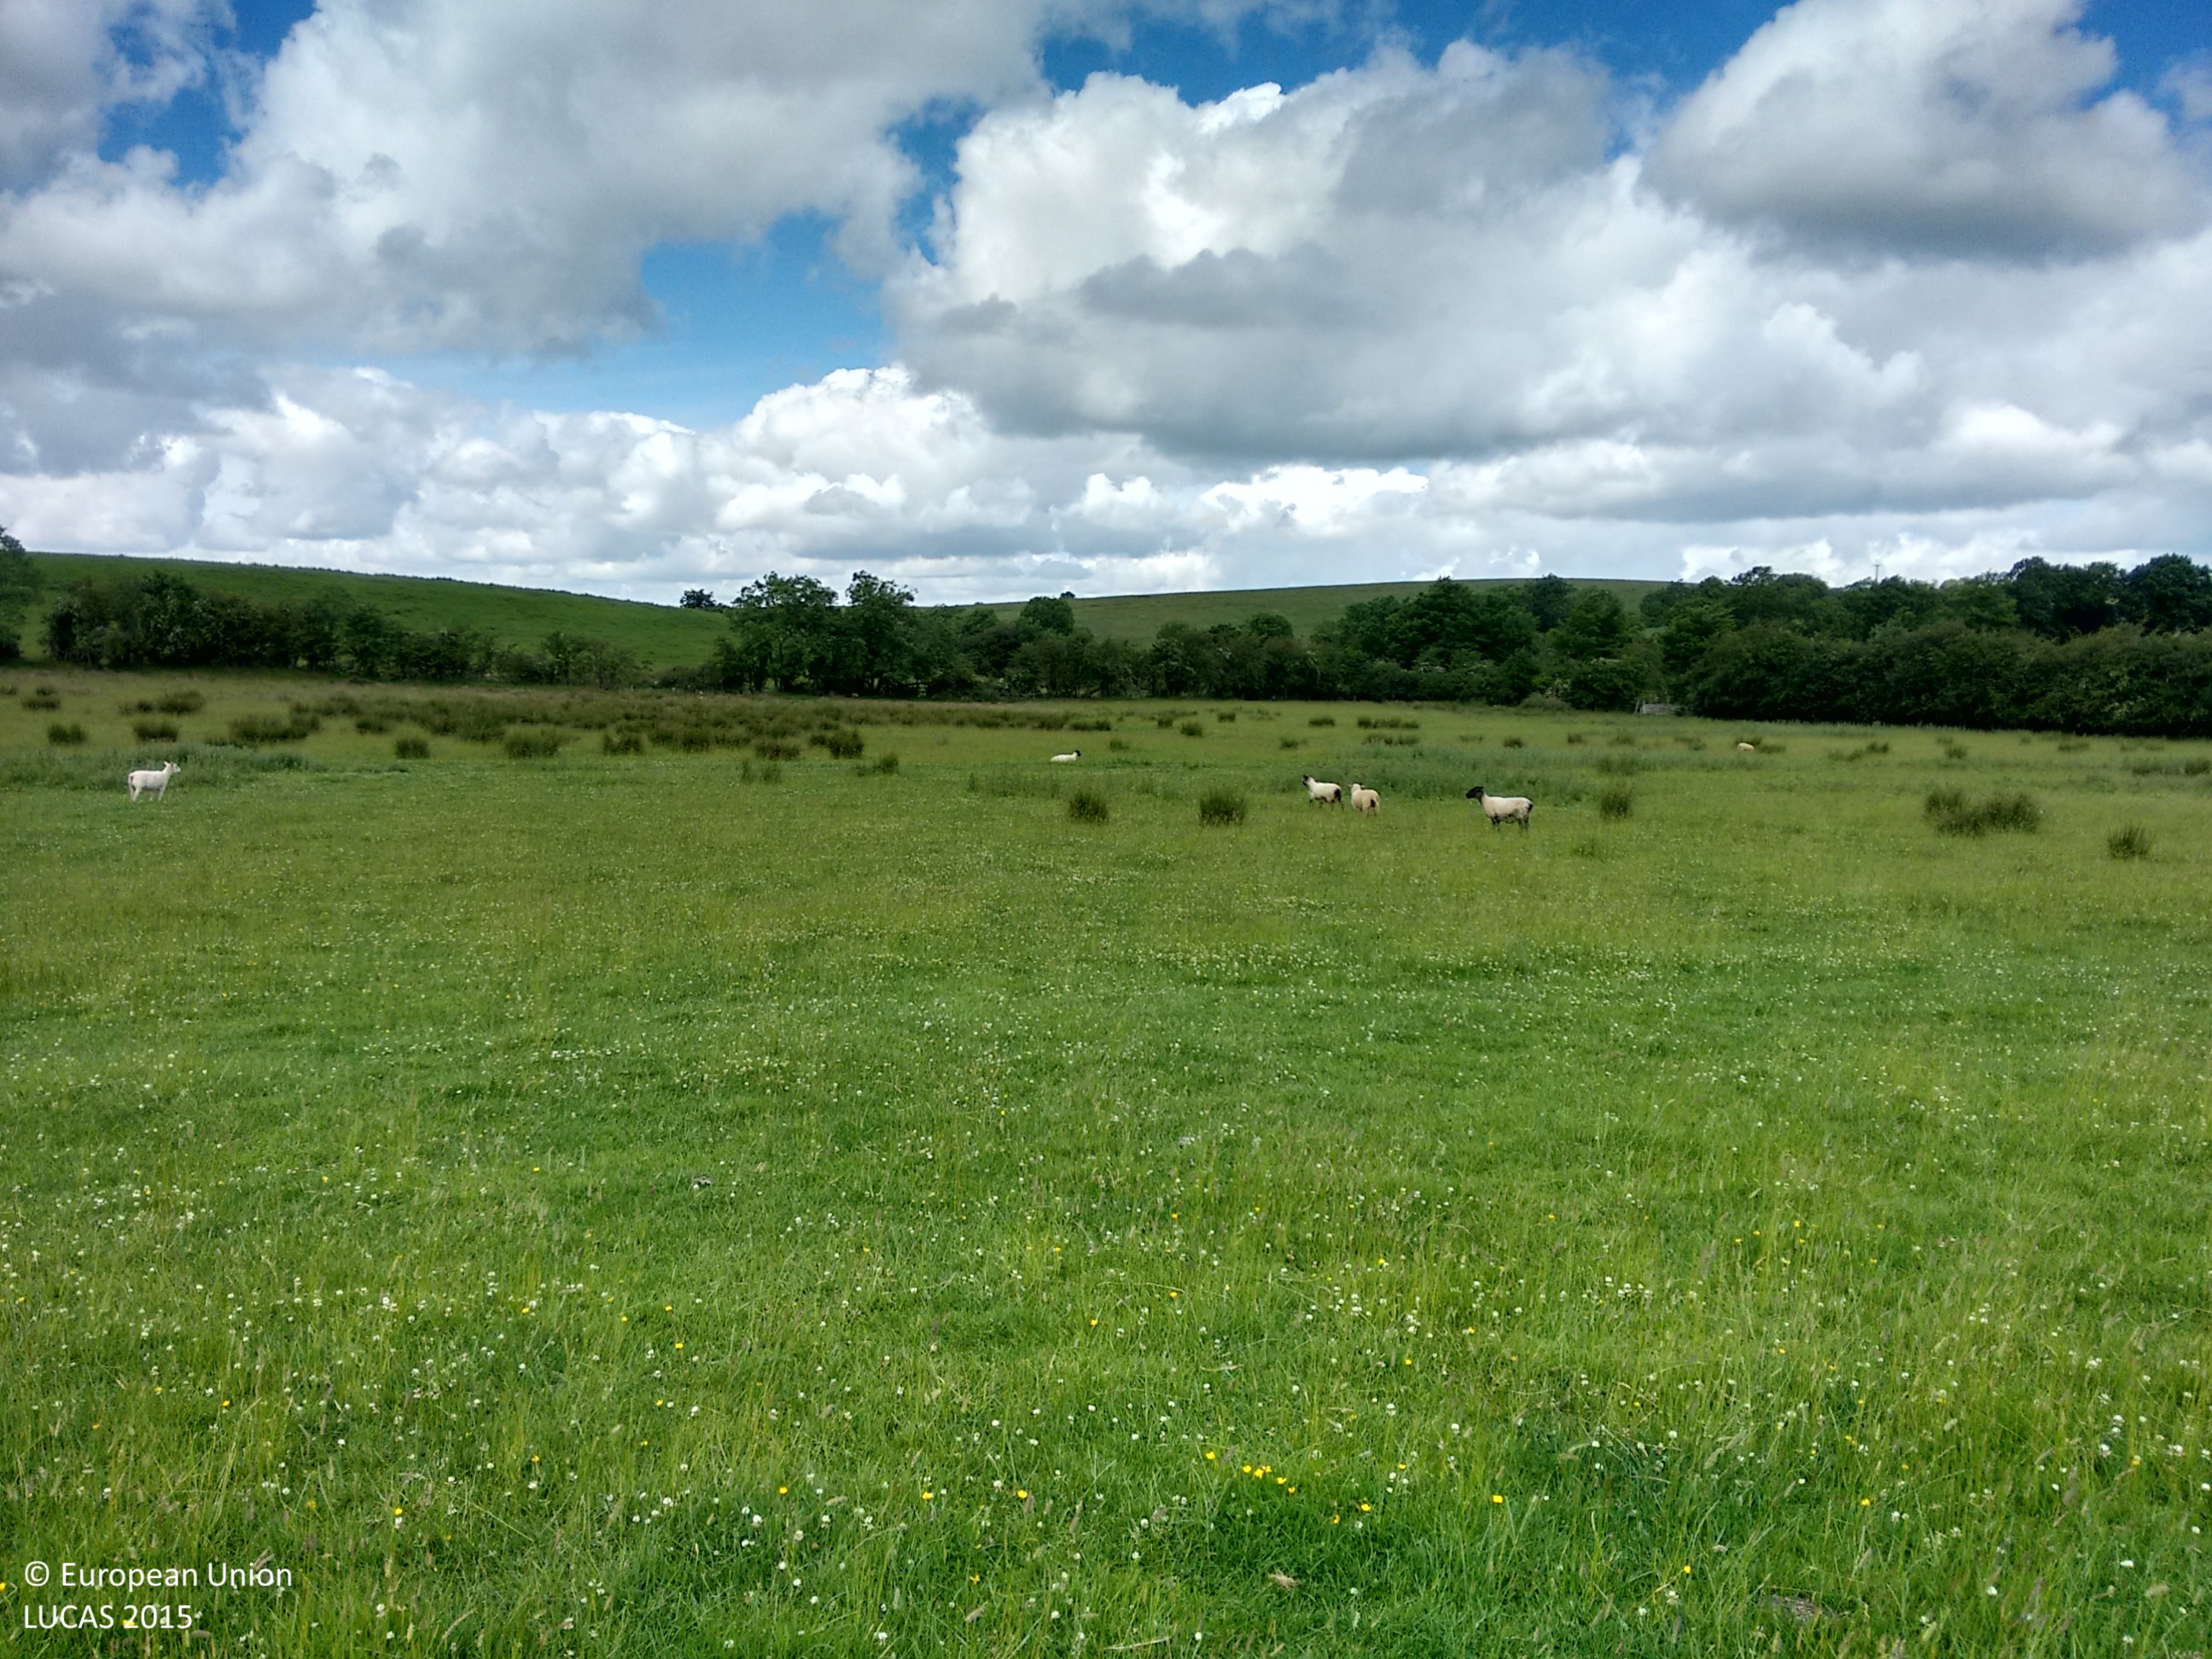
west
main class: Grassland
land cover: Grassland without tree/shrub cover
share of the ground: > 75 %
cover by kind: herbaceous plants 100 %
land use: Agriculture (excluding fallow land and kitchen gardens)
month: July
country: IE
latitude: 53.8463
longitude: -6.7153
